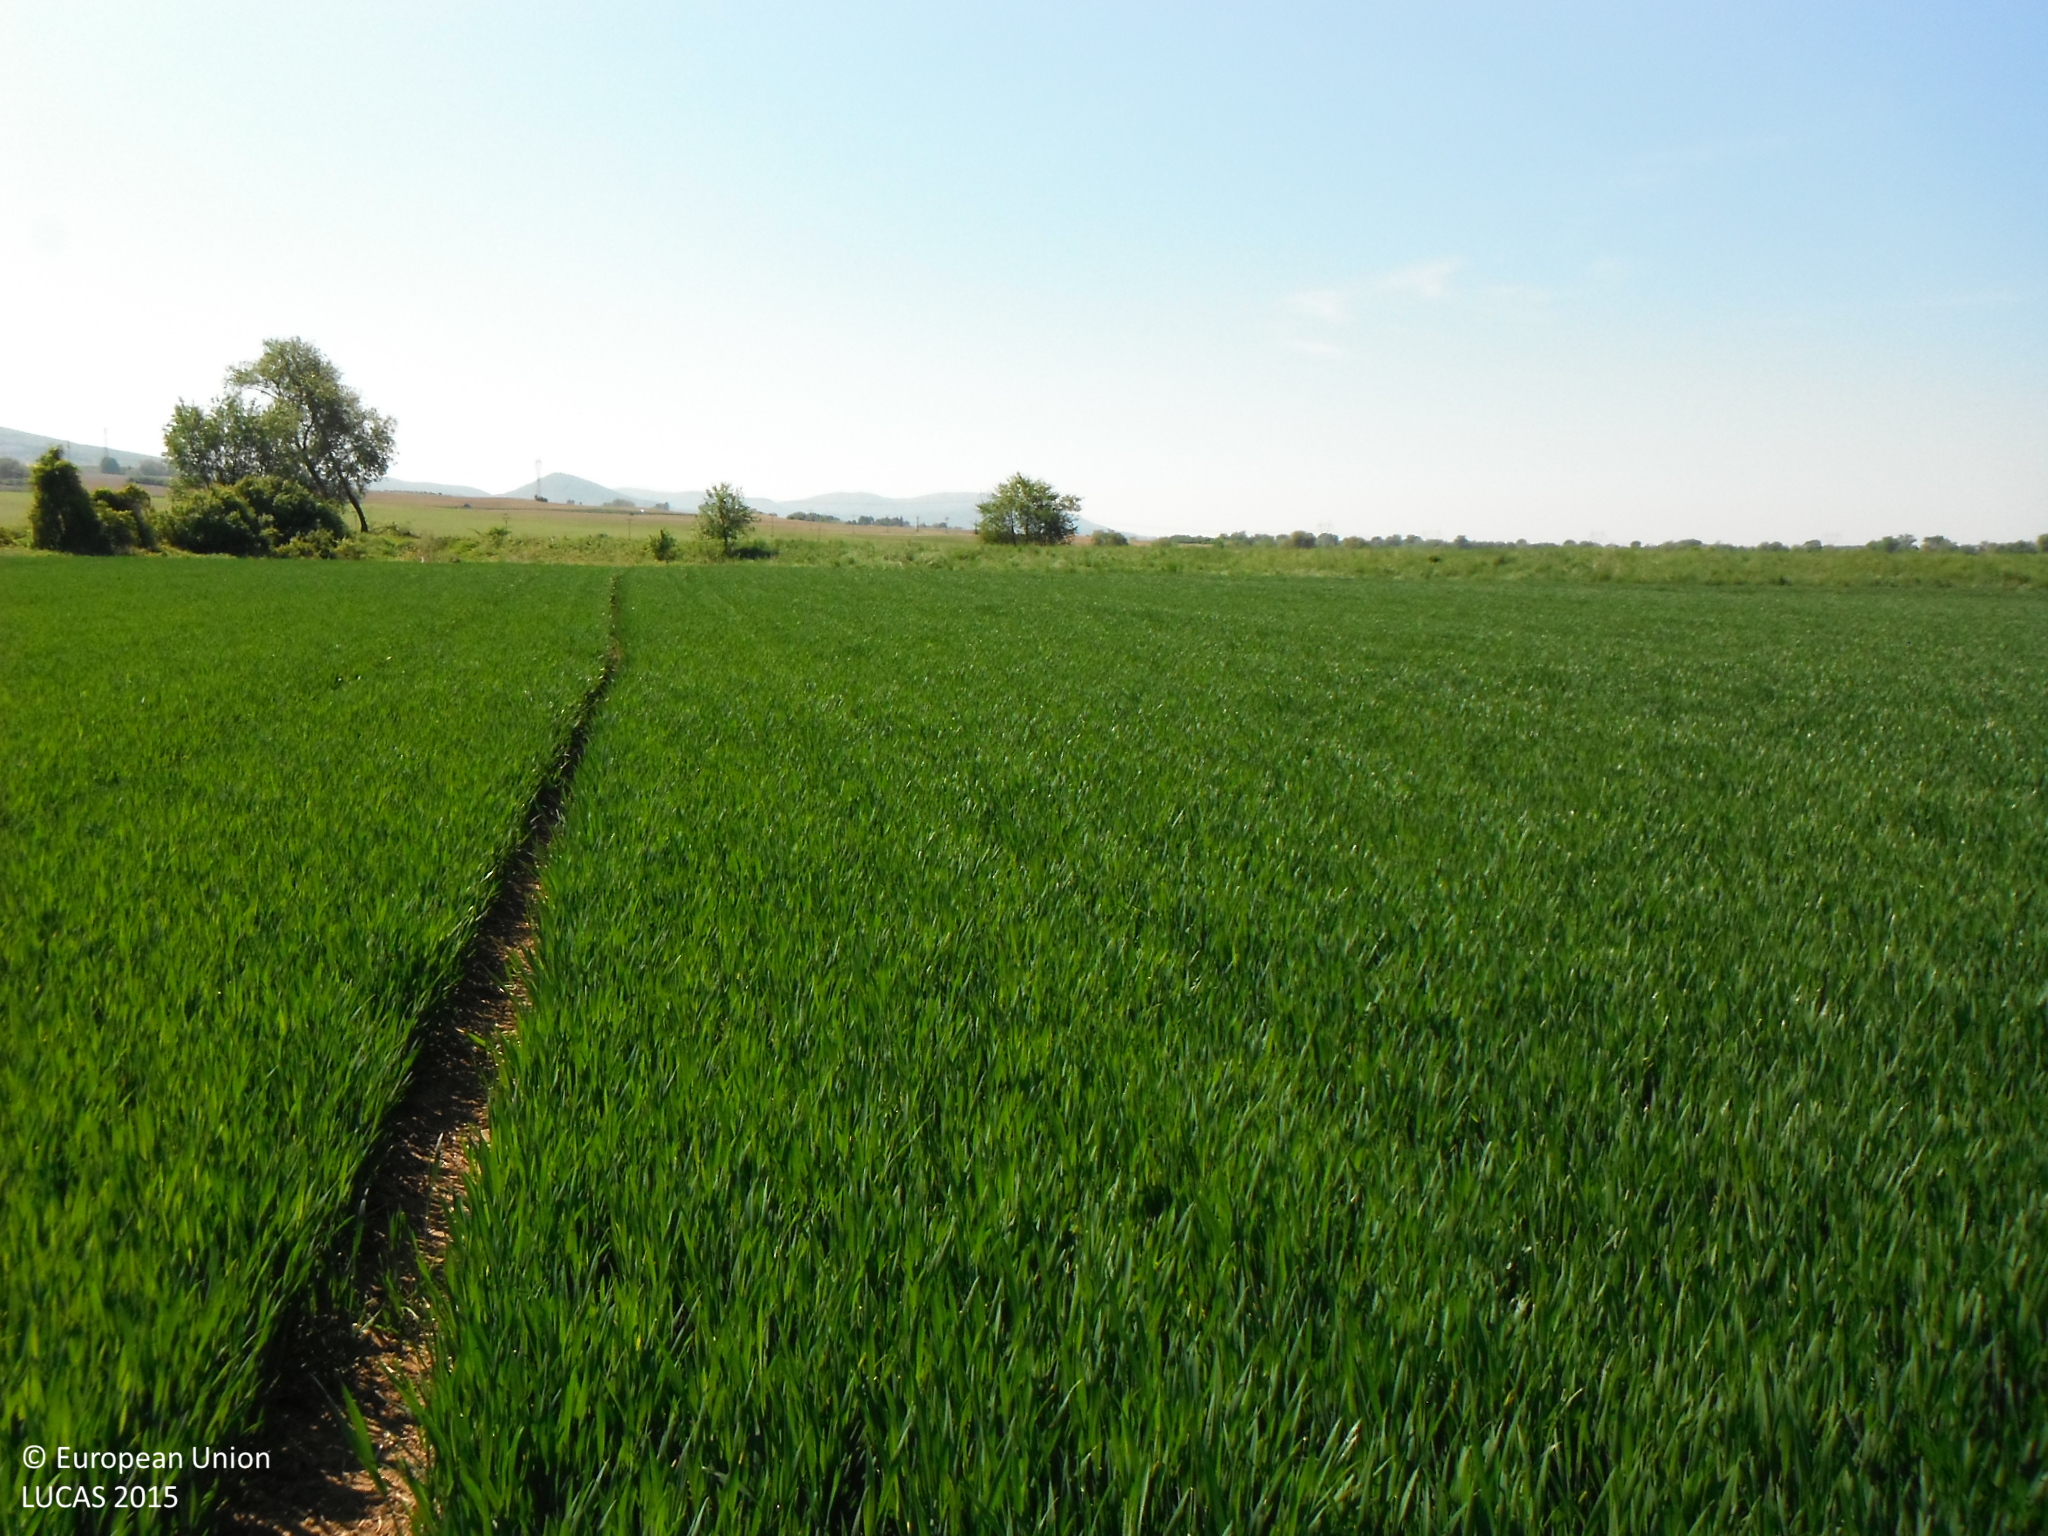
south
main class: Cropland
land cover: Common wheat
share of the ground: > 75 %
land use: Agriculture (excluding fallow land and kitchen gardens)
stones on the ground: < 10 %
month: May
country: SK
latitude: 48.5991
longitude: 21.3409
